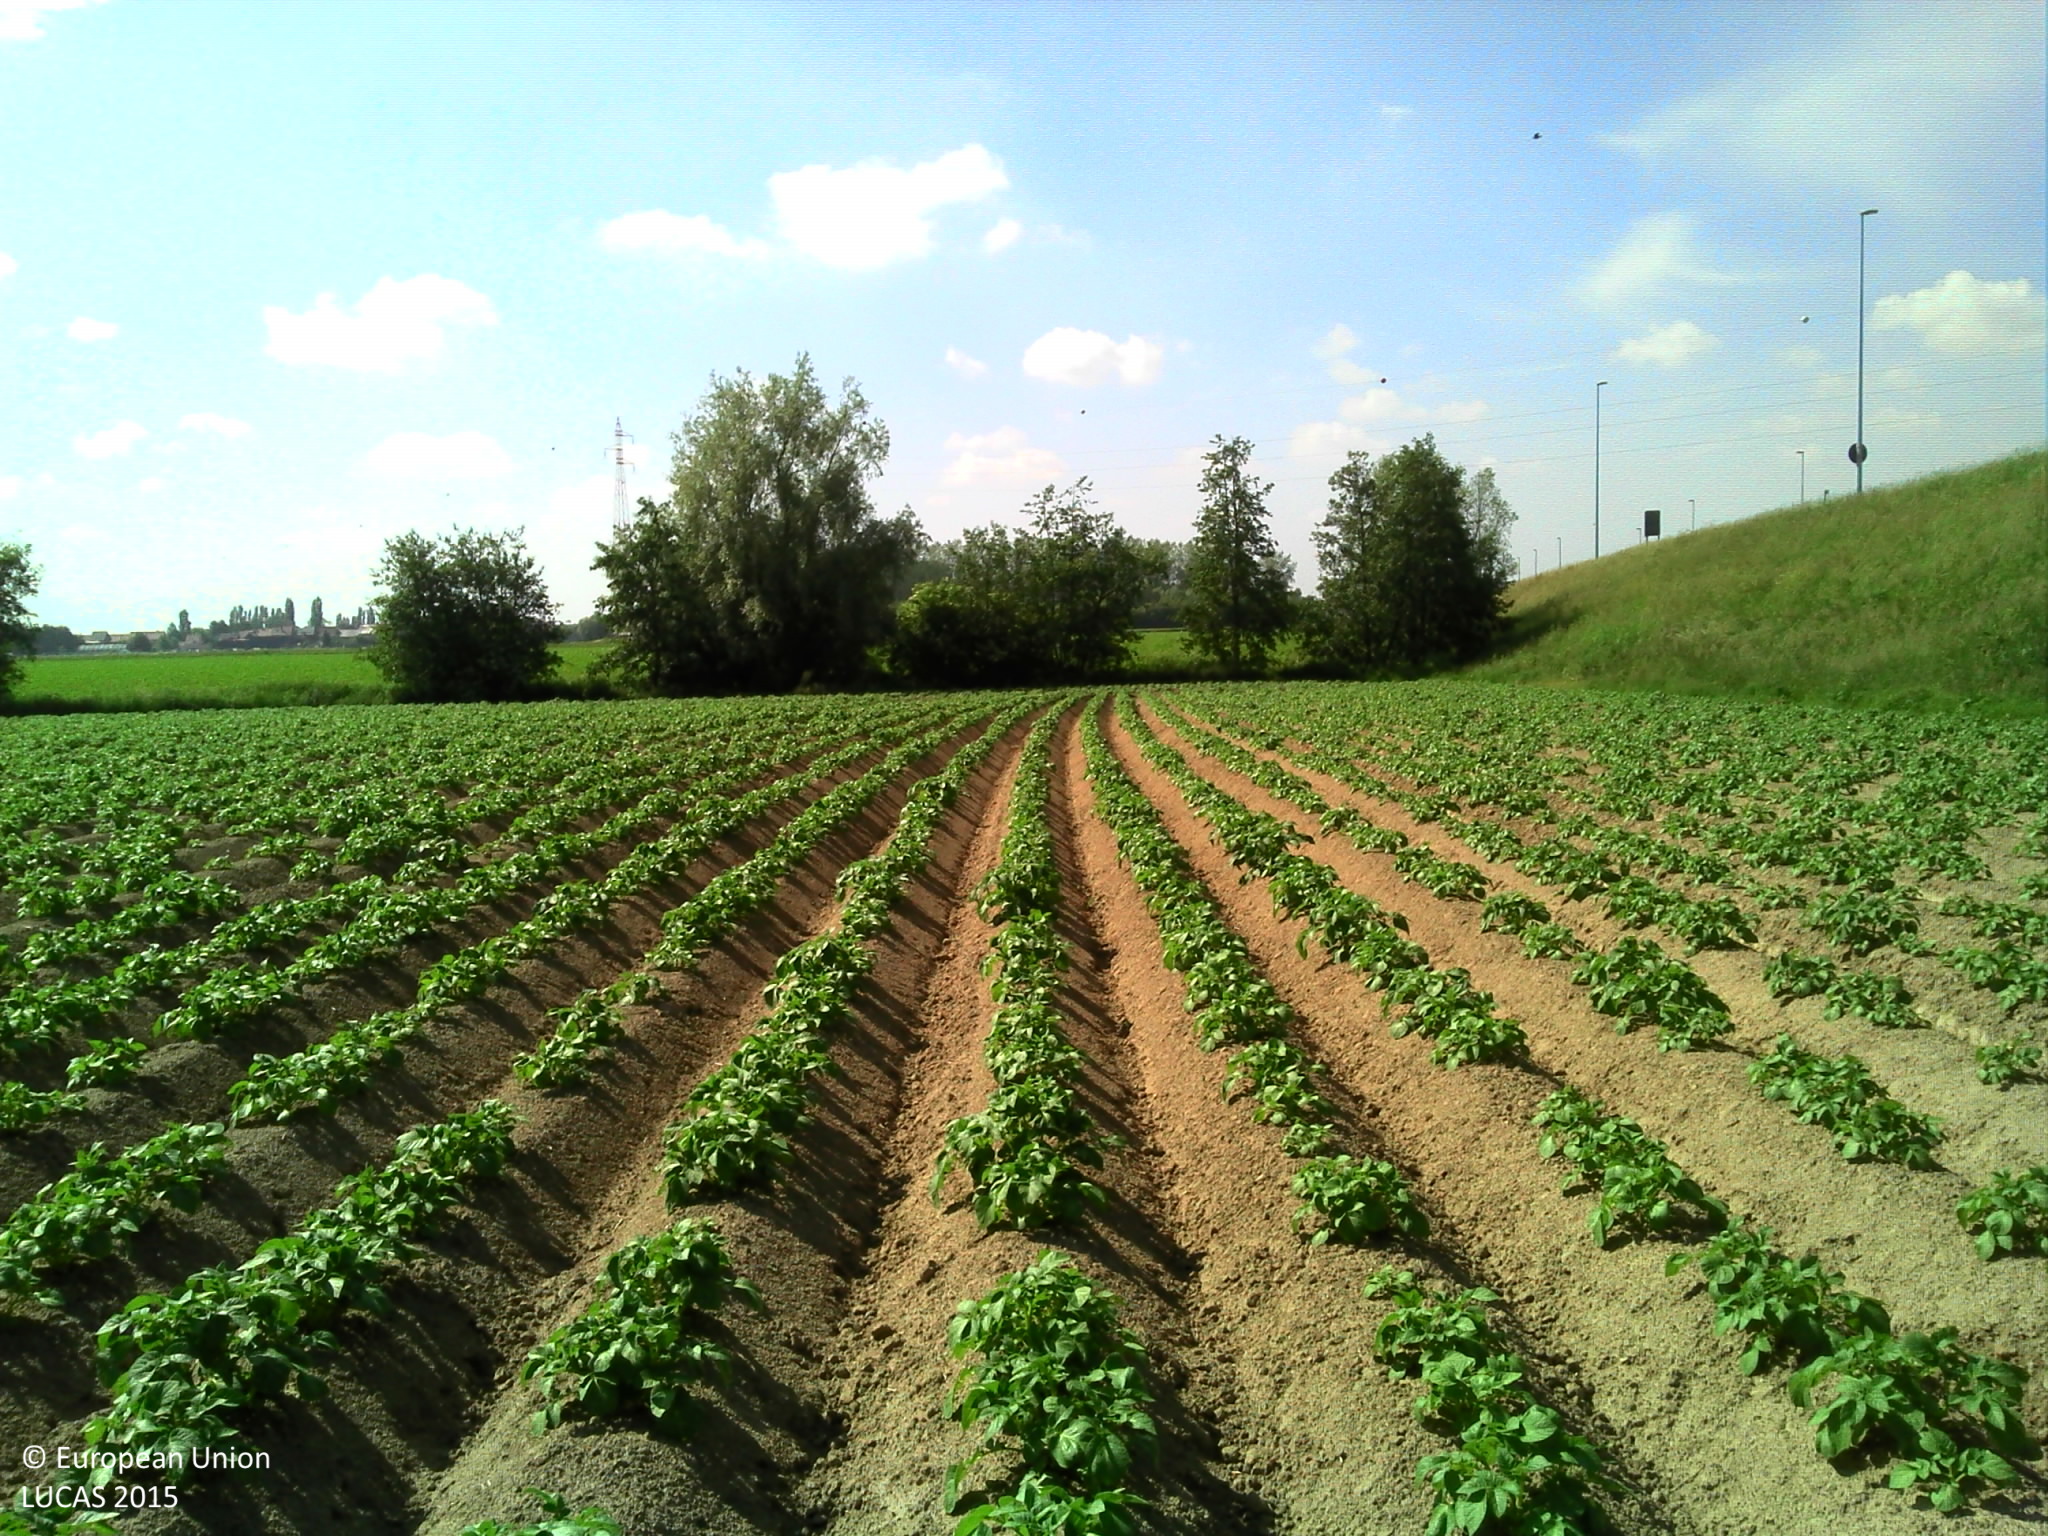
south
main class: Cropland
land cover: Potatoes
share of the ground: 10 - 25 %
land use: Agriculture (excluding fallow land and kitchen gardens)
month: June
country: BE
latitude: 50.8075
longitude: 3.1364
